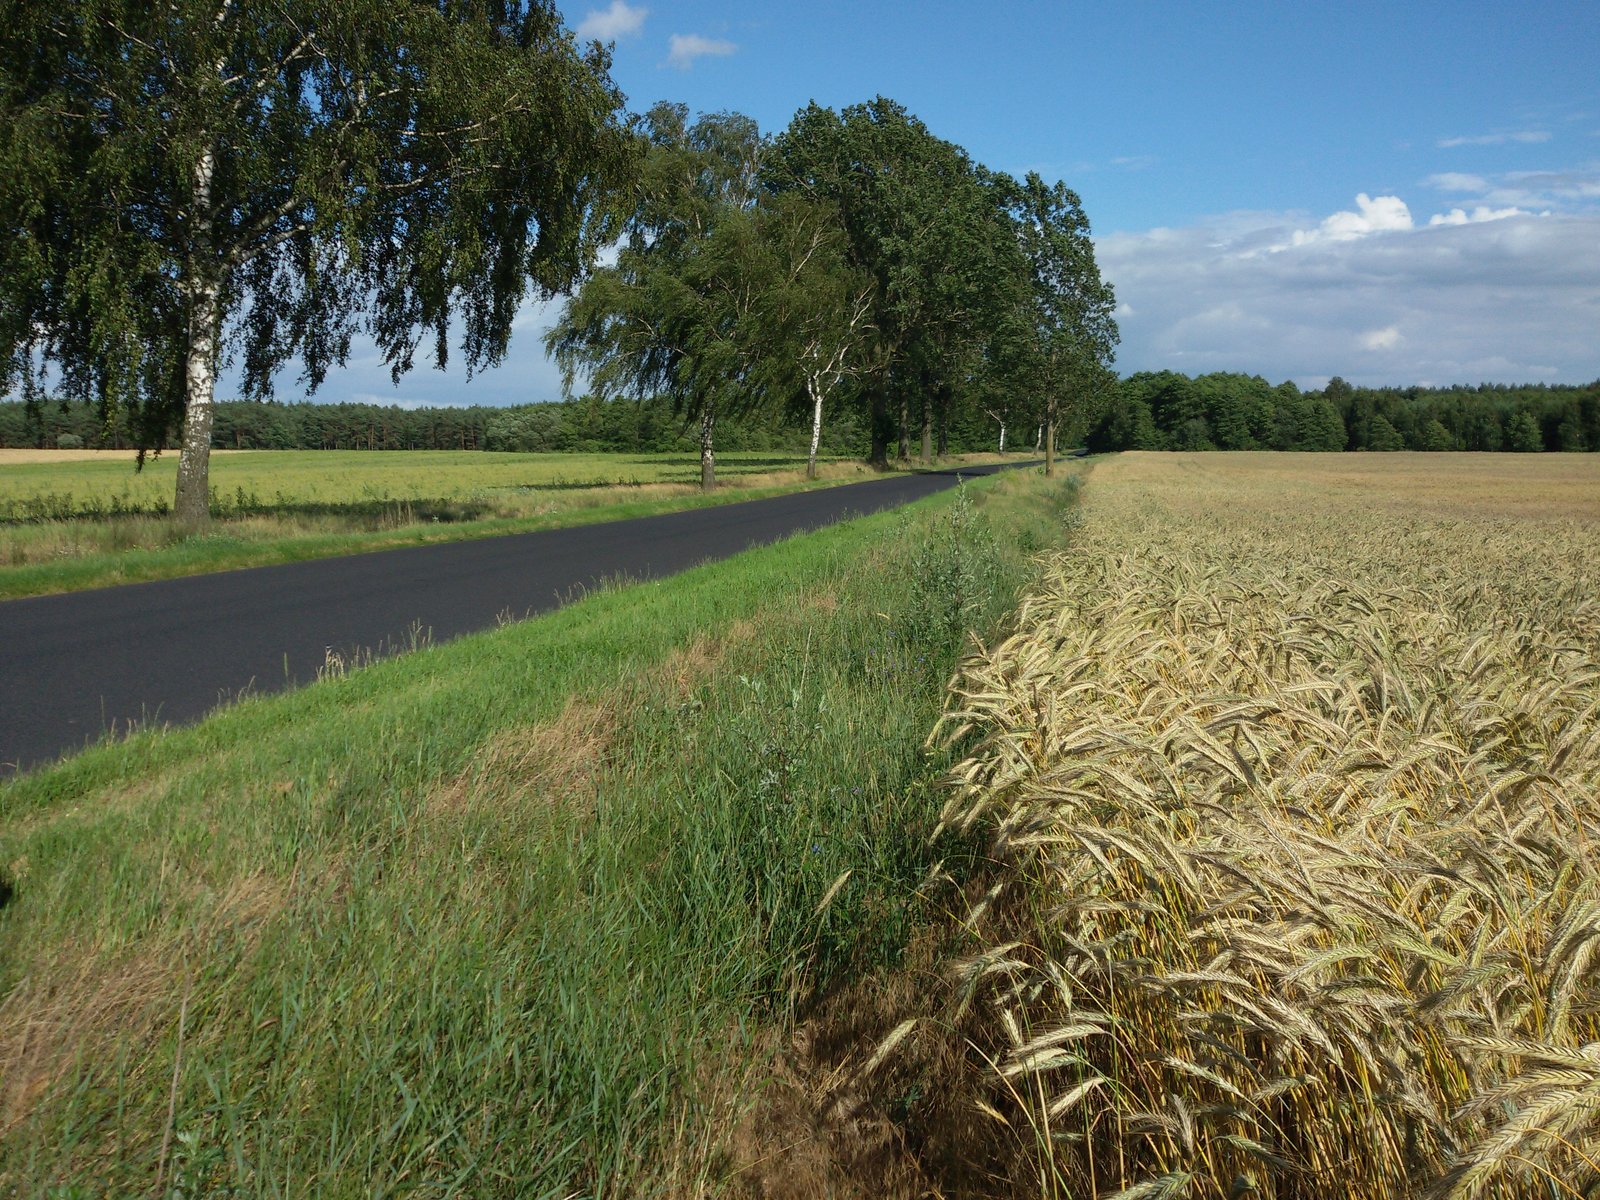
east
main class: Cropland
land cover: Triticale
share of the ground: > 75 %
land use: Agriculture (excluding fallow land and kitchen gardens)
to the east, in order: Triticale; Inland marshes; Triticale
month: July
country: PL
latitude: 52.7290
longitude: 17.6094
